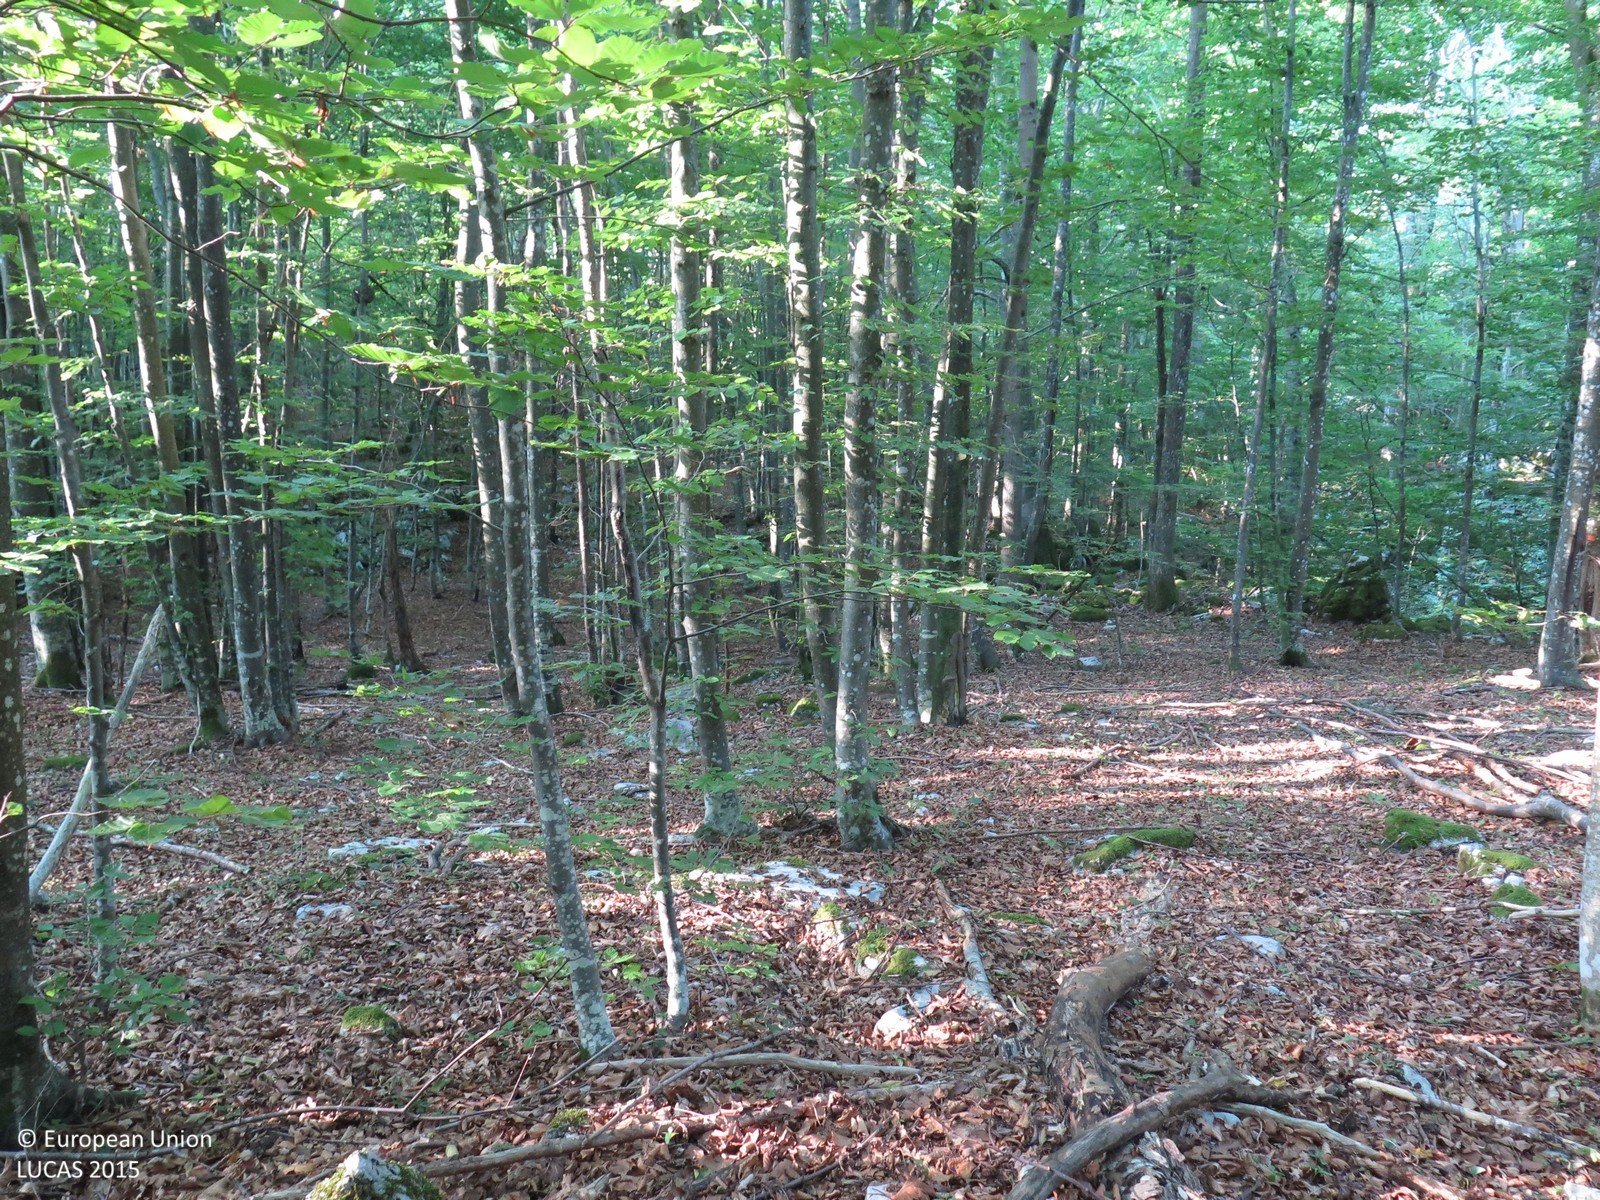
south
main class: Woodland
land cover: Broadleaved woodland
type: beech forest
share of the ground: > 75 %
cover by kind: broadleaved forest trees 95 %, lichens and mosses 5 %
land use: Forestry
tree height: > 5 m
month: August
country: HR
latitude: 45.4764
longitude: 14.9974
